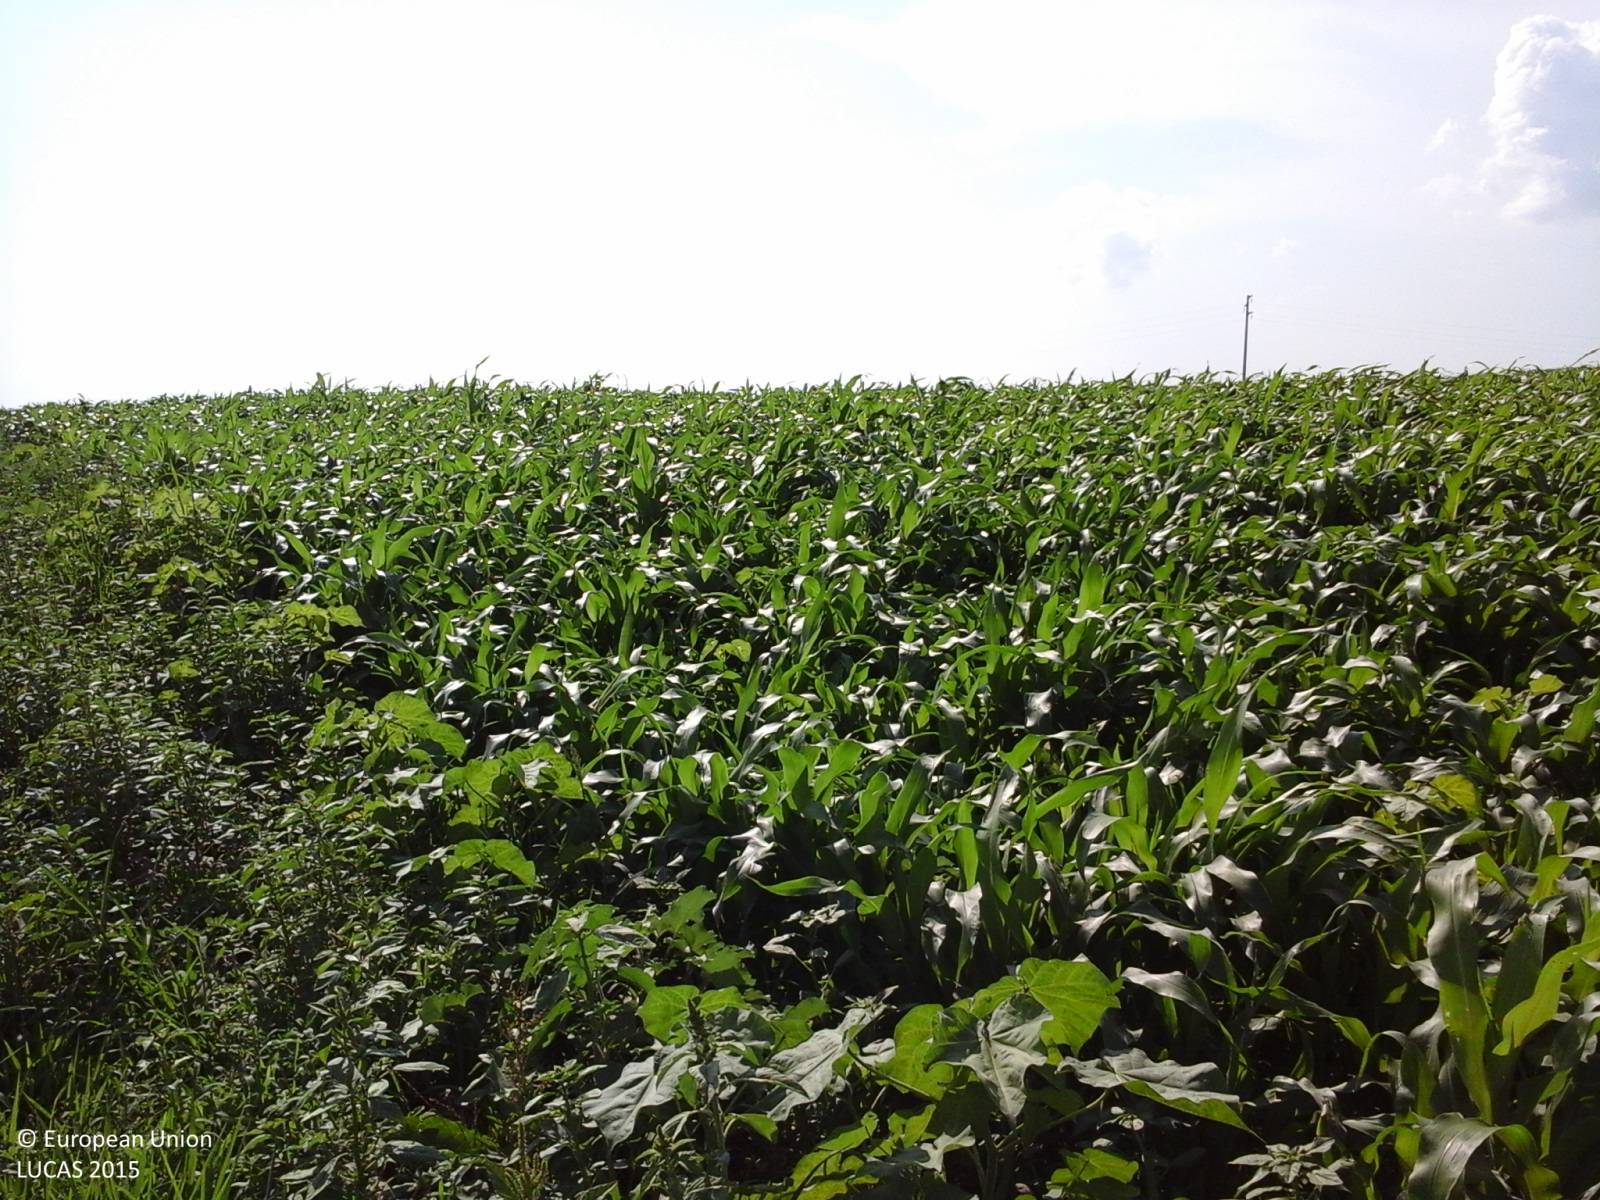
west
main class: Cropland
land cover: Maize
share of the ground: > 75 %
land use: Agriculture (excluding fallow land and kitchen gardens)
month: July
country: IT
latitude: 42.0305
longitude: 12.3467
